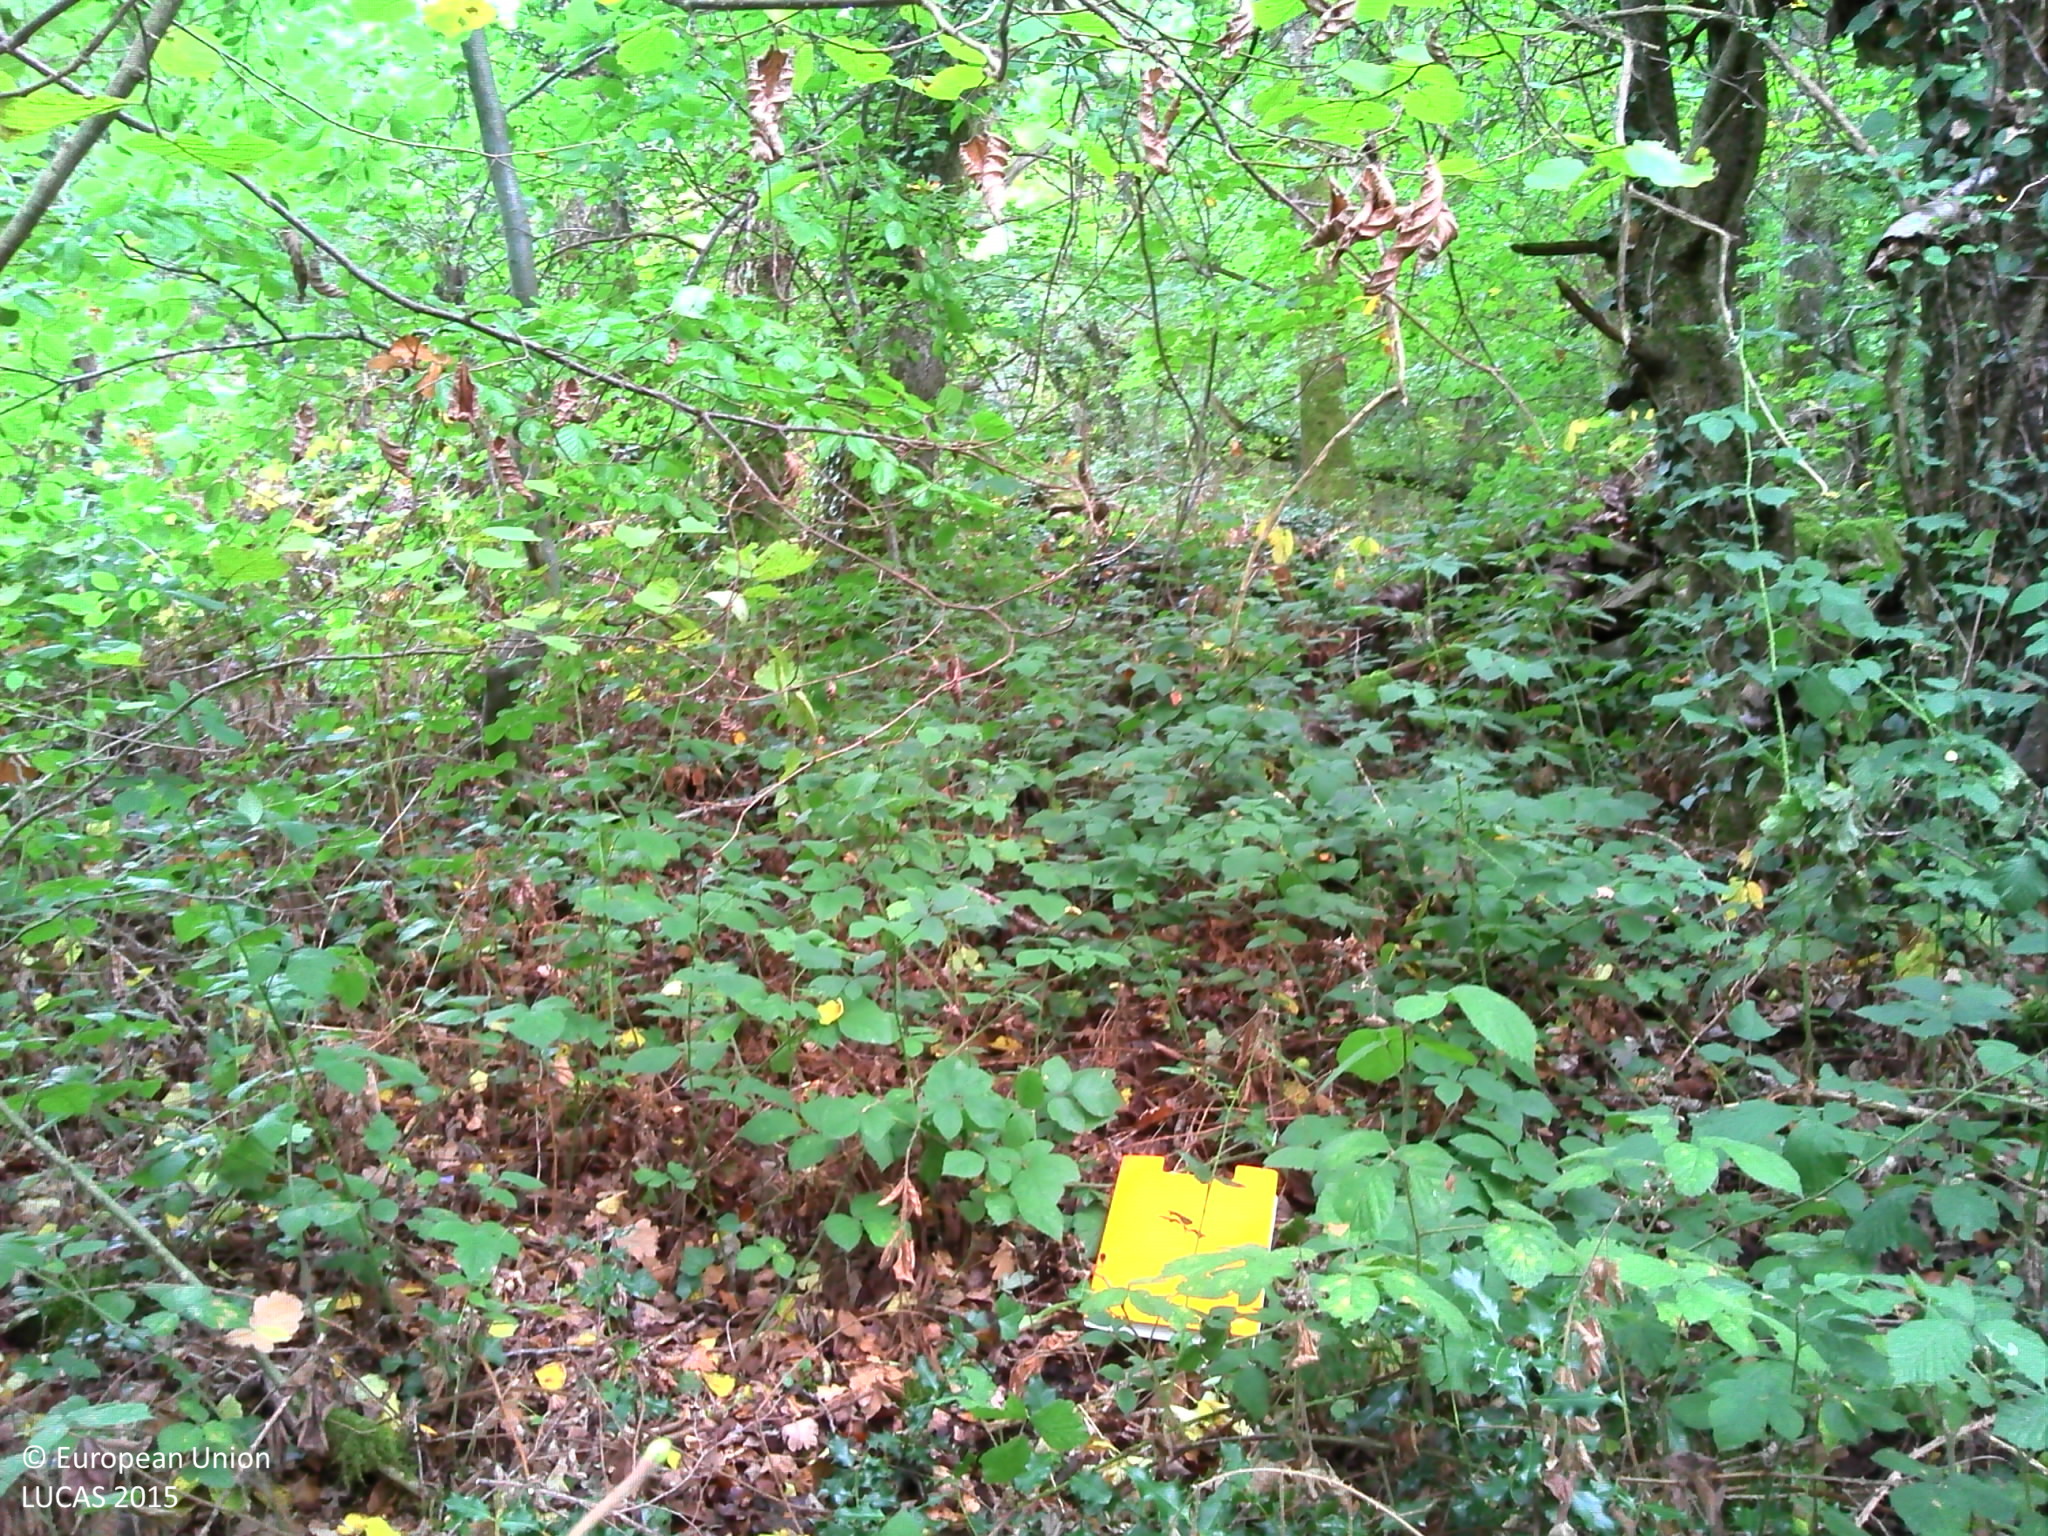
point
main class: Woodland
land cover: Broadleaved woodland
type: beech forest
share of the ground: > 75 %
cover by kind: broadleaved forest trees 90 %, herbaceous plants 10 %
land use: Forestry
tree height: > 5 m
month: September
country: FR
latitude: 46.2188
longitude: 2.8285
